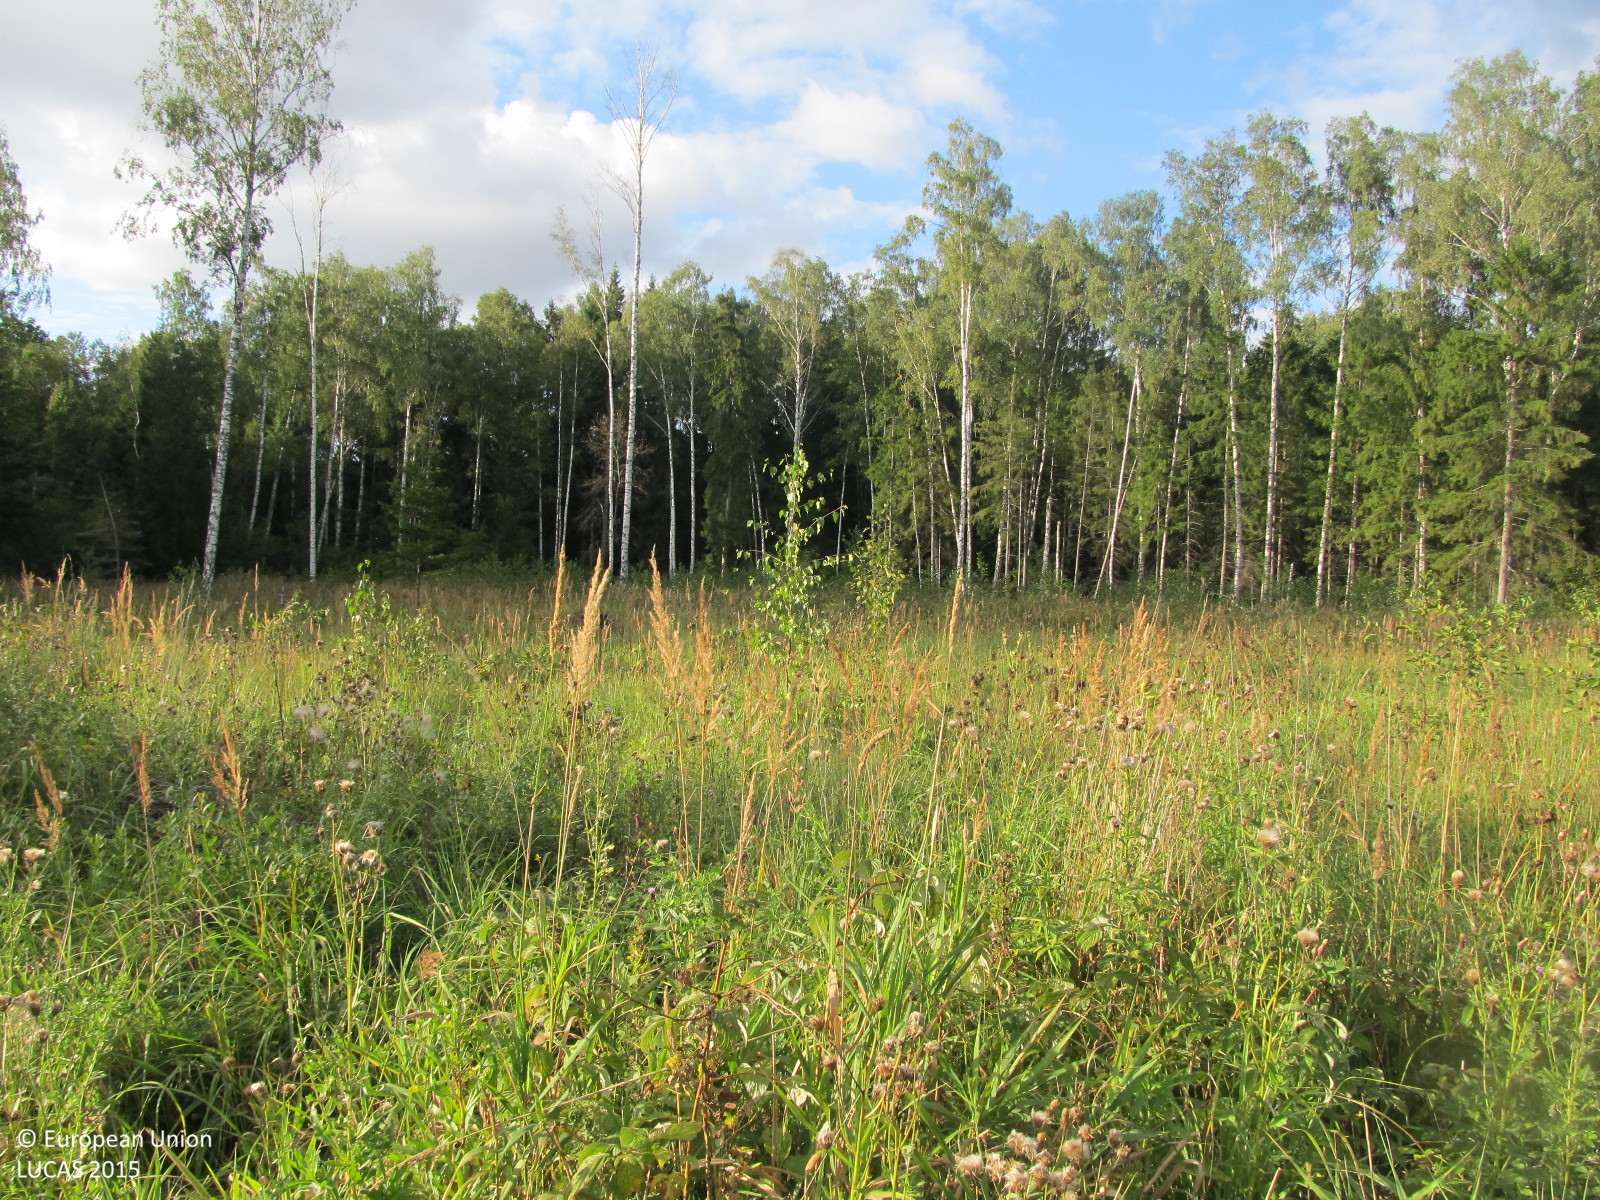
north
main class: Grassland
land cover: Spontaneously vegetated surfaces
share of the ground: > 75 %
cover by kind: herbaceous plants 95 %, shrubs 5 %
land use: Forestry
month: September
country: LT
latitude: 56.1606
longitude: 23.3576
